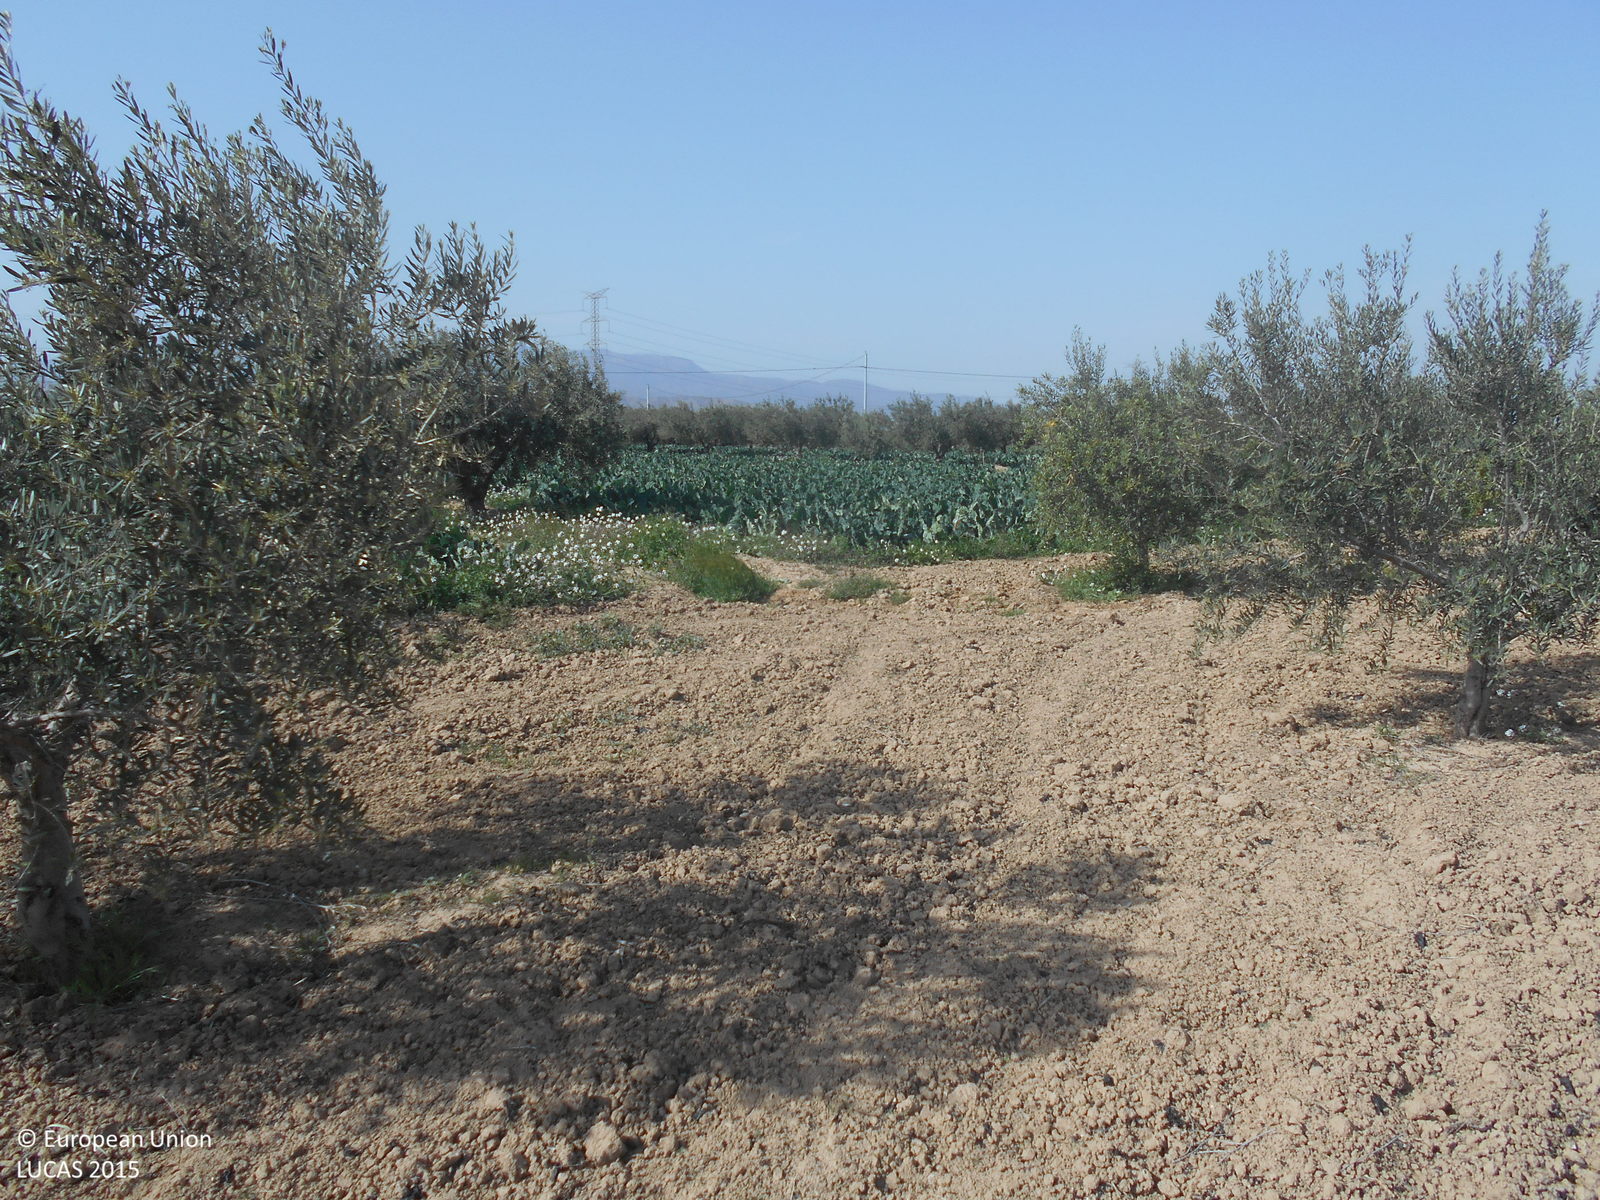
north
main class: Cropland
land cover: Vineyards
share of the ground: 25 - 50 %
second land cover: Other bare soil
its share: > 75 %
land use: Agriculture (excluding fallow land and kitchen gardens)
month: April
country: ES
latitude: 37.7041
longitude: -1.5174
